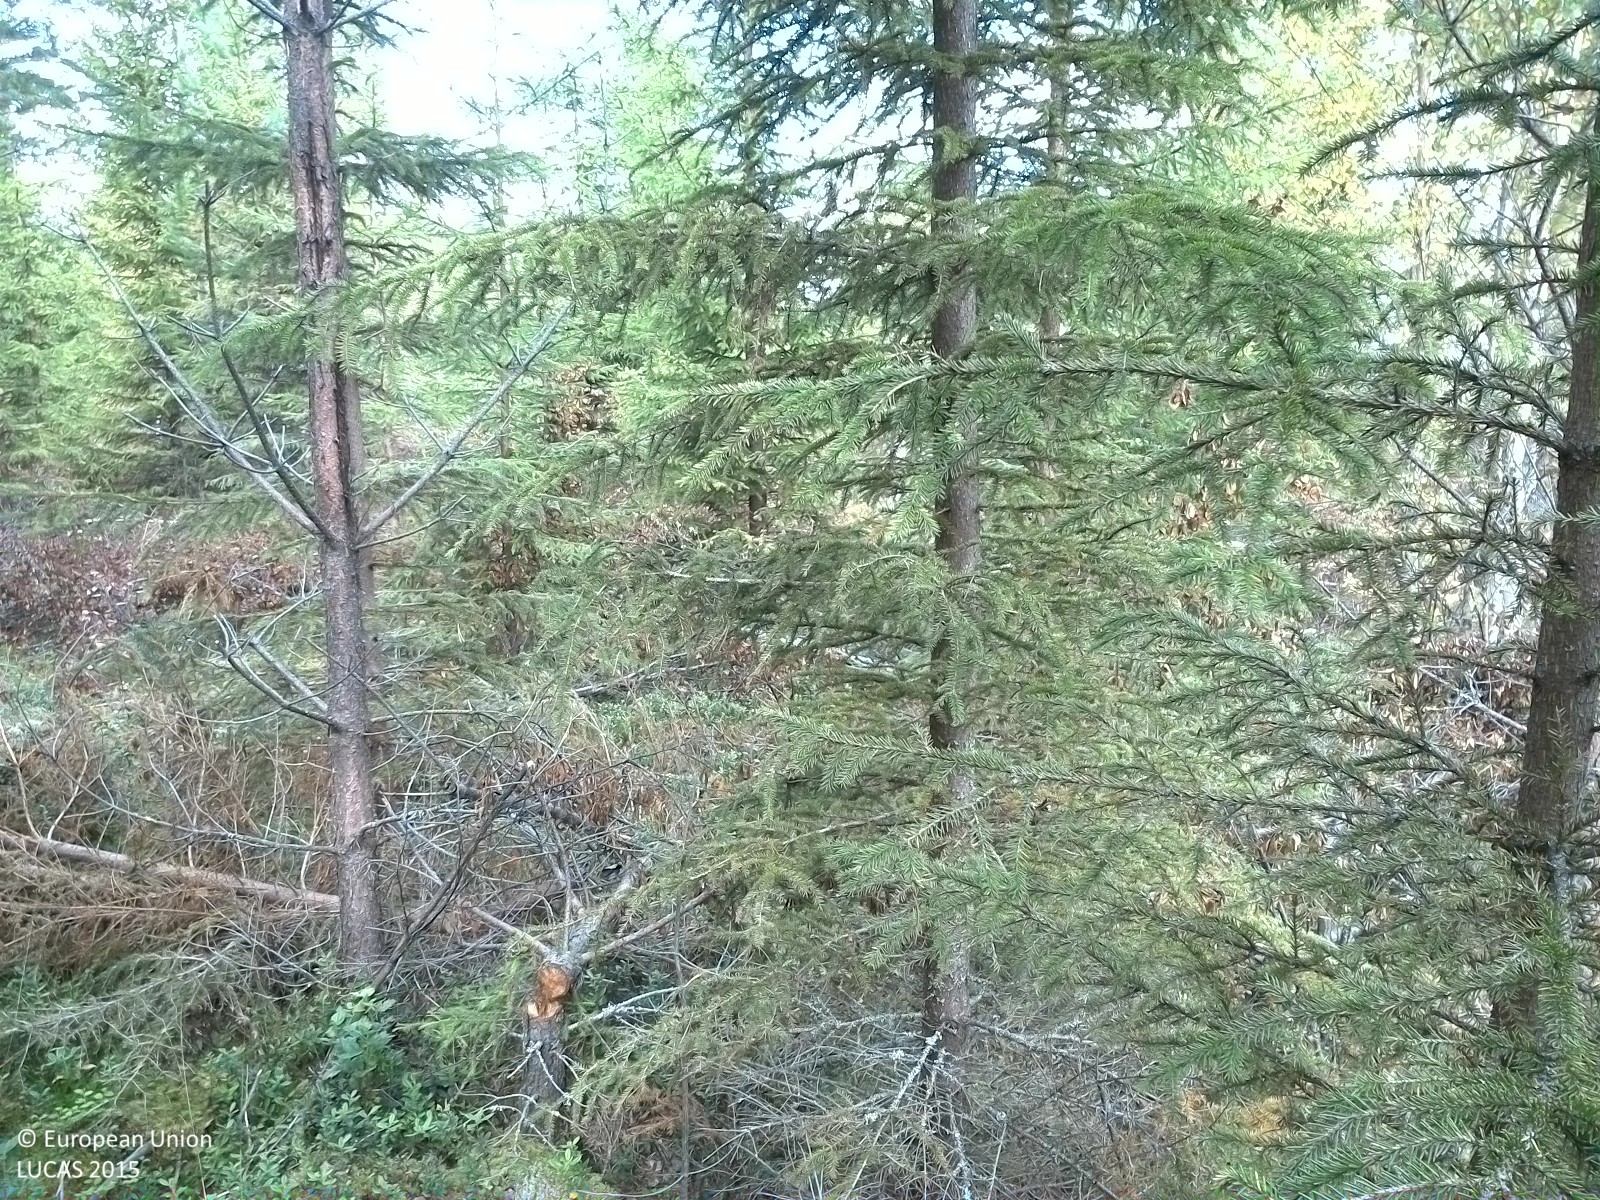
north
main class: Woodland
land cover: Spruce dominated coniferous woodland
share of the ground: 50 - 75 %
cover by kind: coniferous forest trees 45 %, lichens and mosses 30 %, shrubs 20 %, broadleaved forest trees 5 %
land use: Forestry
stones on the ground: < 10 %
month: September
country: SE
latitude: 62.4712
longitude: 16.0884
